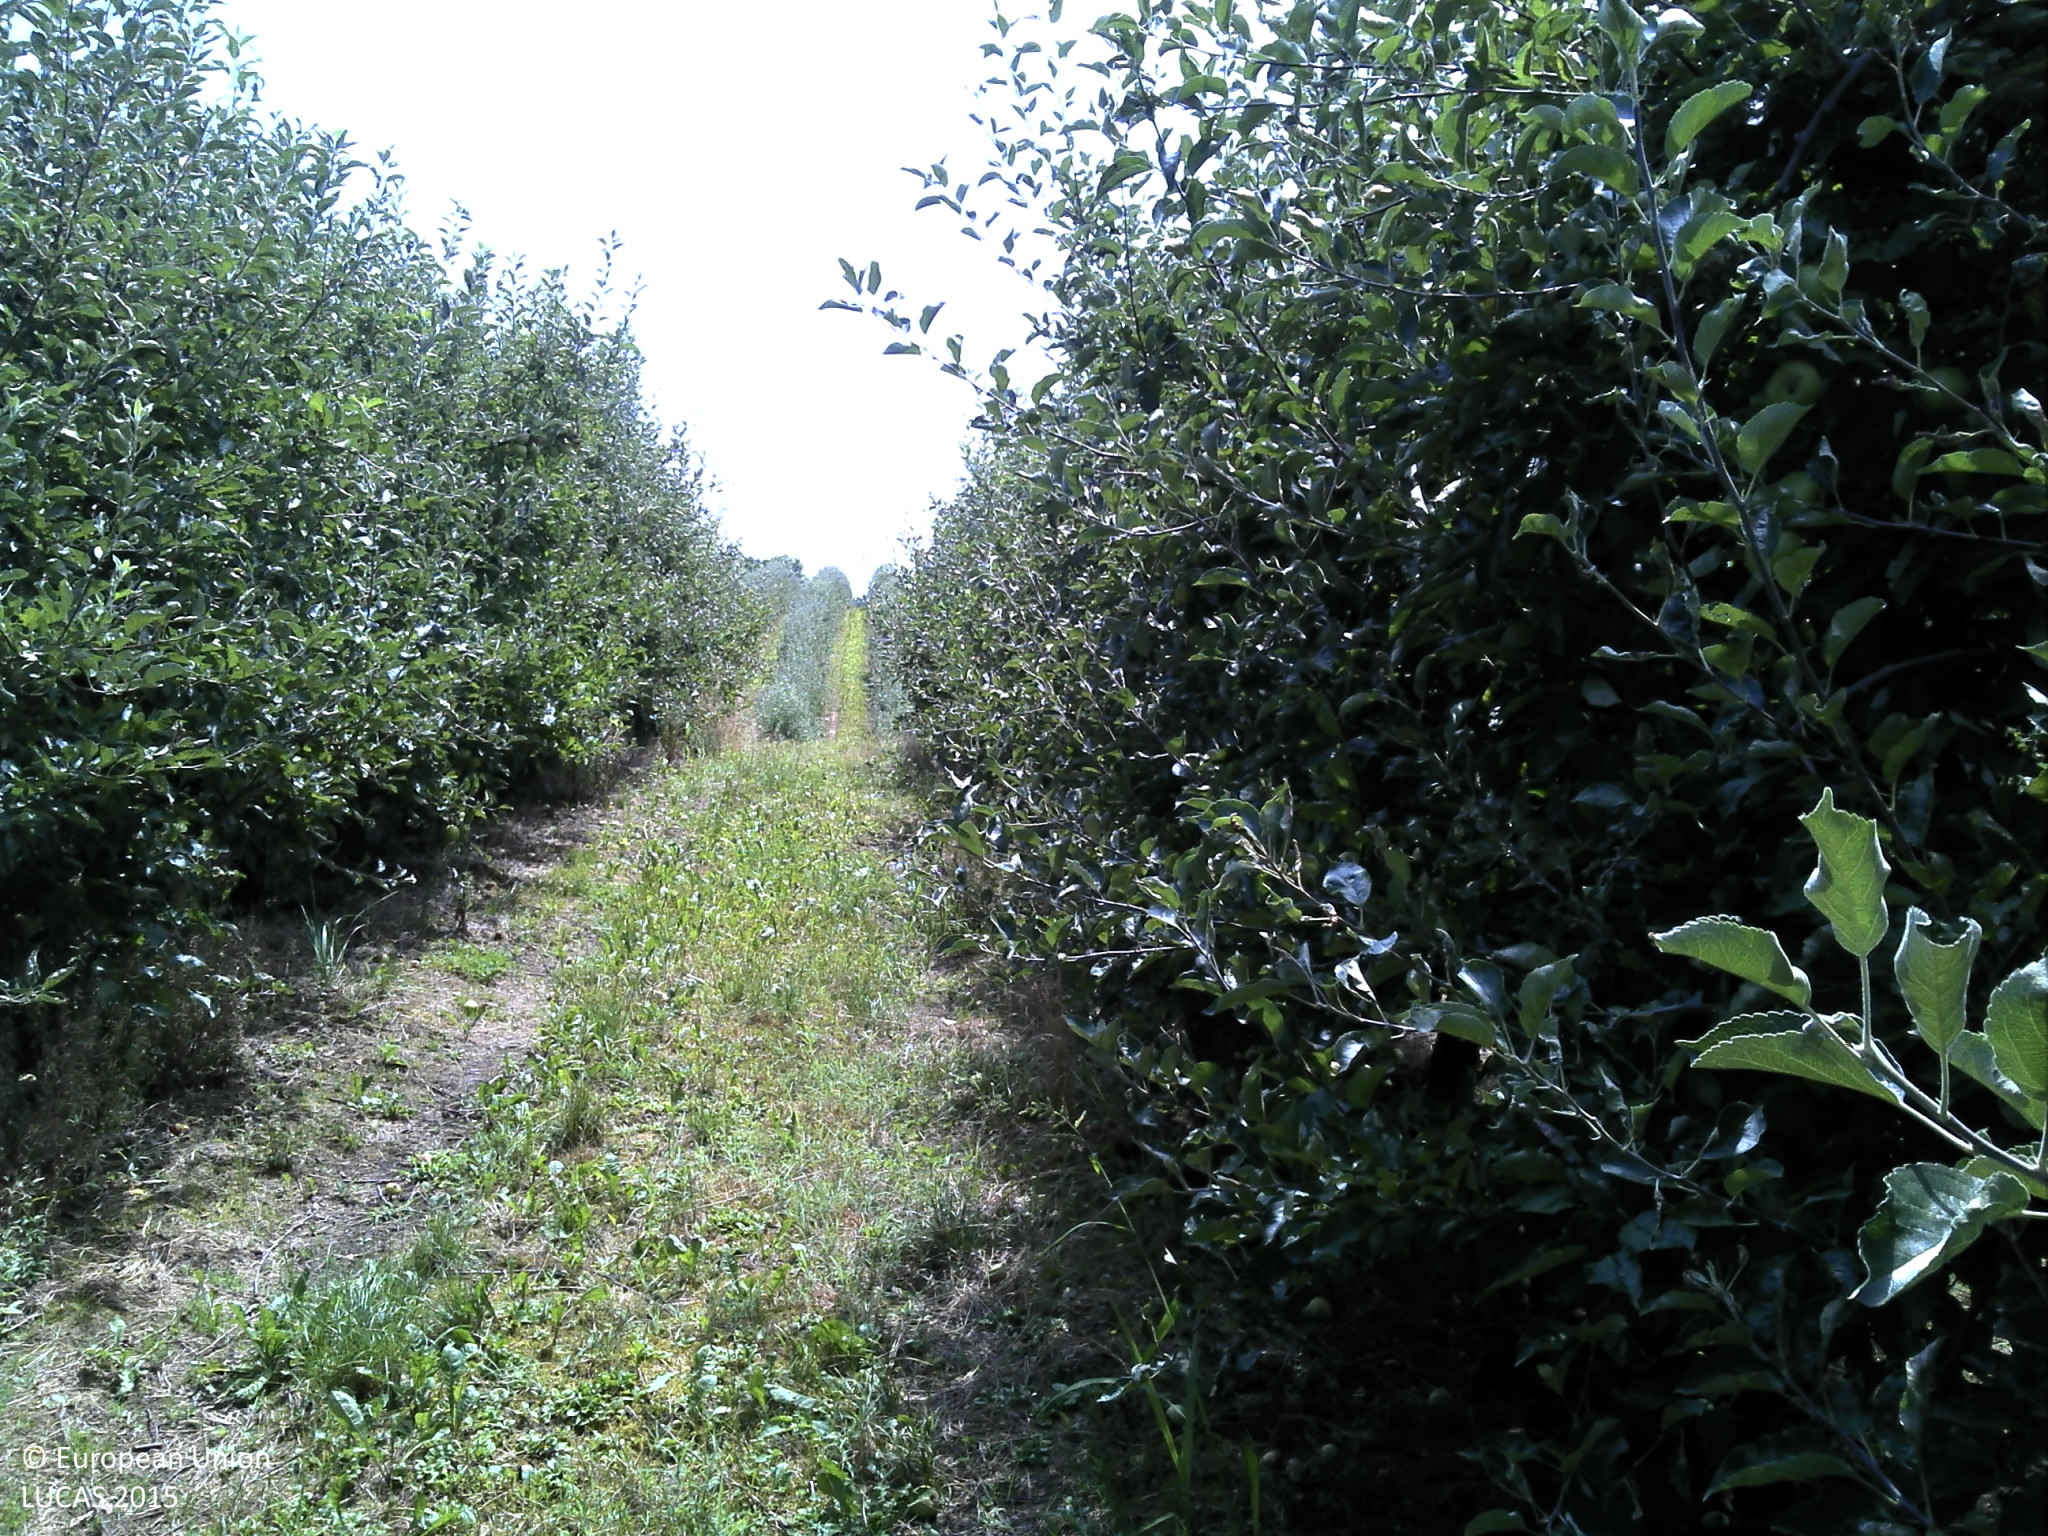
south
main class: Cropland
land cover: Apple fruit
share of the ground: > 75 %
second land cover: Spontaneously vegetated surfaces
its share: > 75 %
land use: Kitchen garden
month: July
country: HR
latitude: 45.6393
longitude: 16.6318
